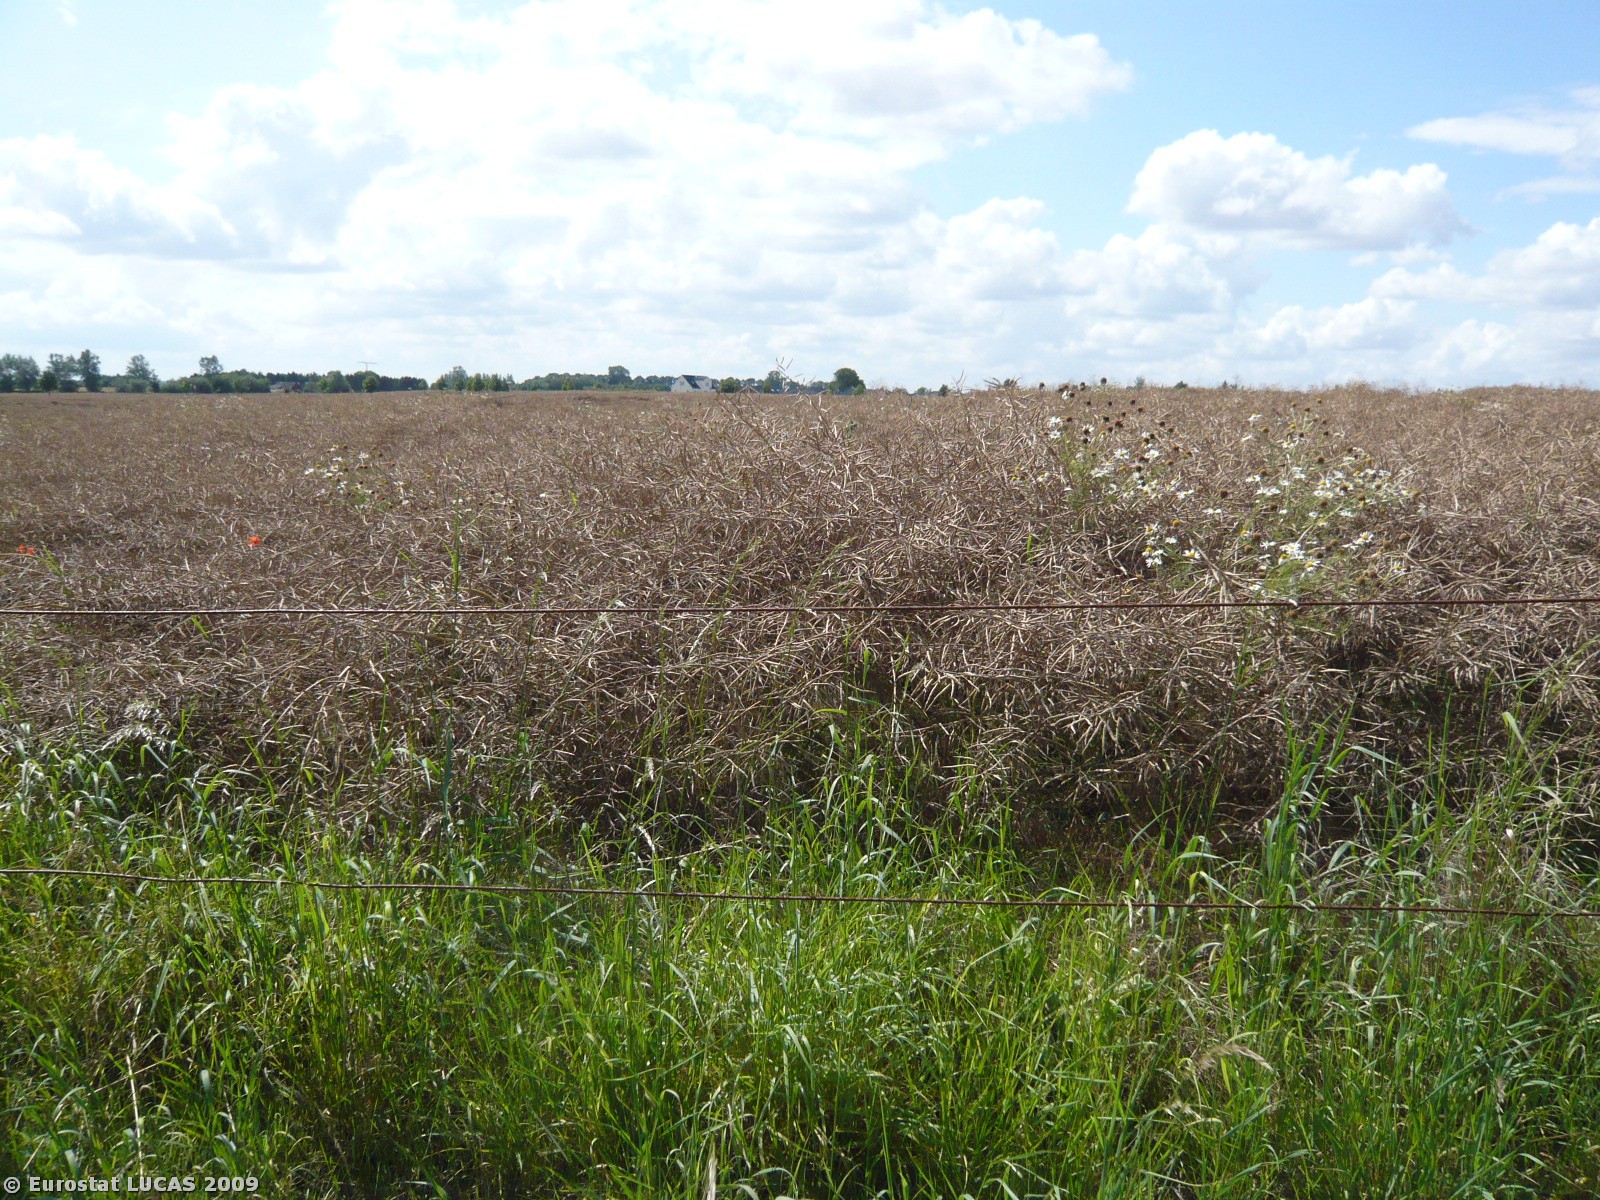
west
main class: Cropland
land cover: Rape and turnip rape
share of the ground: > 75 %
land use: Agriculture (excluding fallow land and kitchen gardens)
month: July
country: DK
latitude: 55.5406
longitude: 12.1376
